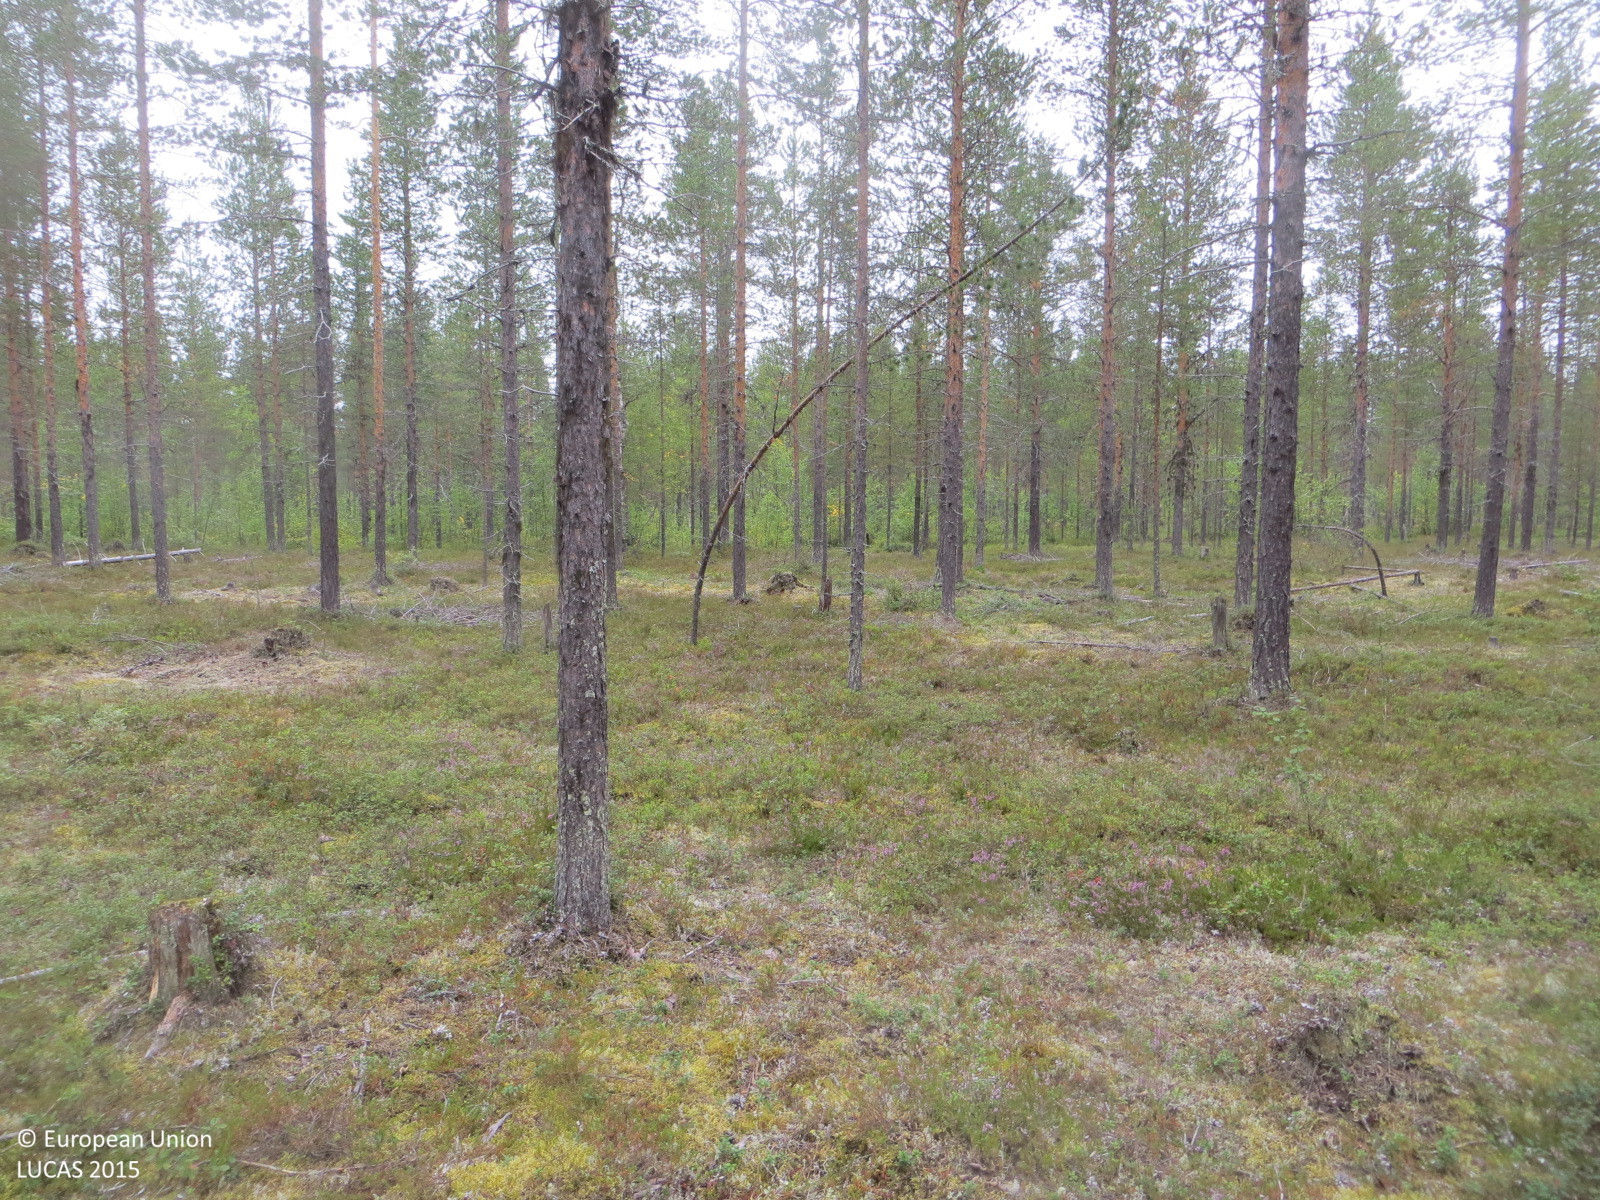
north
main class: Woodland
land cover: Pine dominated coniferous woodland
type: boreal forest
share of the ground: 50 - 75 %
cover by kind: coniferous forest trees 50 %, shrubs 25 %, lichens and mosses 25 %
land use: Forestry
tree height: > 5 m
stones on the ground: < 10 %
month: August
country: FI
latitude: 67.3644
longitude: 23.8295
